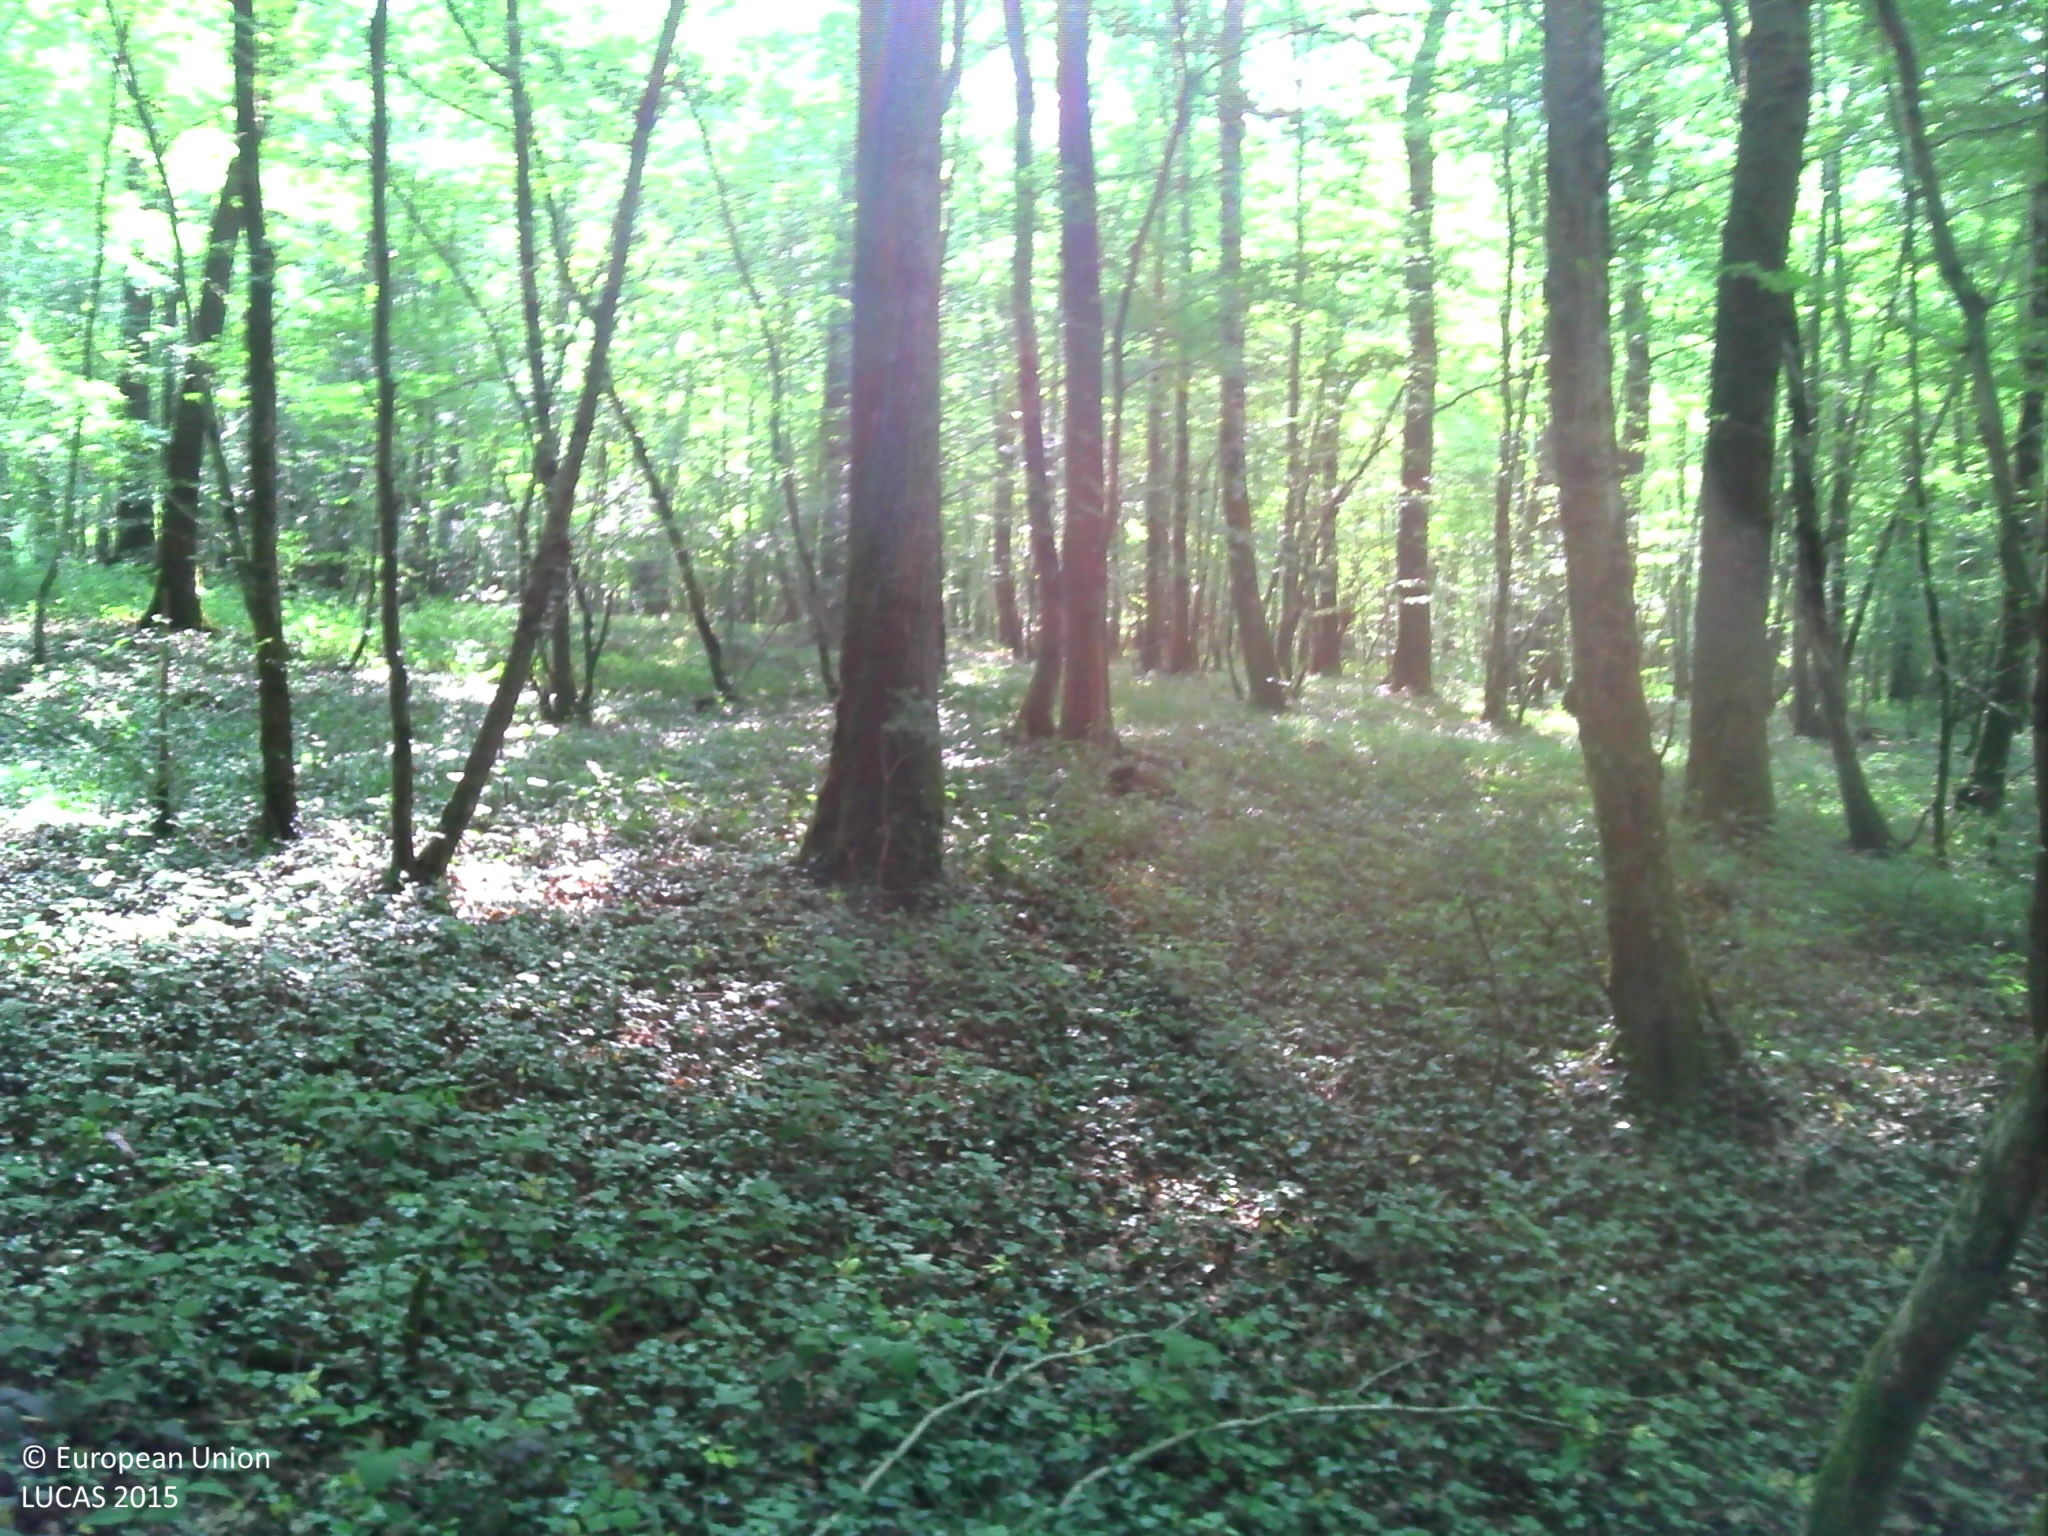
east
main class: Woodland
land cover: Broadleaved woodland
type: beech forest
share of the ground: > 75 %
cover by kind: broadleaved forest trees 95 %, herbaceous plants 5 %
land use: Forestry
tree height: > 5 m
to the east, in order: Broadleaved woodland; Ditches and canals; Tracks; Ditches and canals; Broadleaved woodland; Tracks; Broadleaved woodland
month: June
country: FR
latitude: 47.8676
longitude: 6.1374
